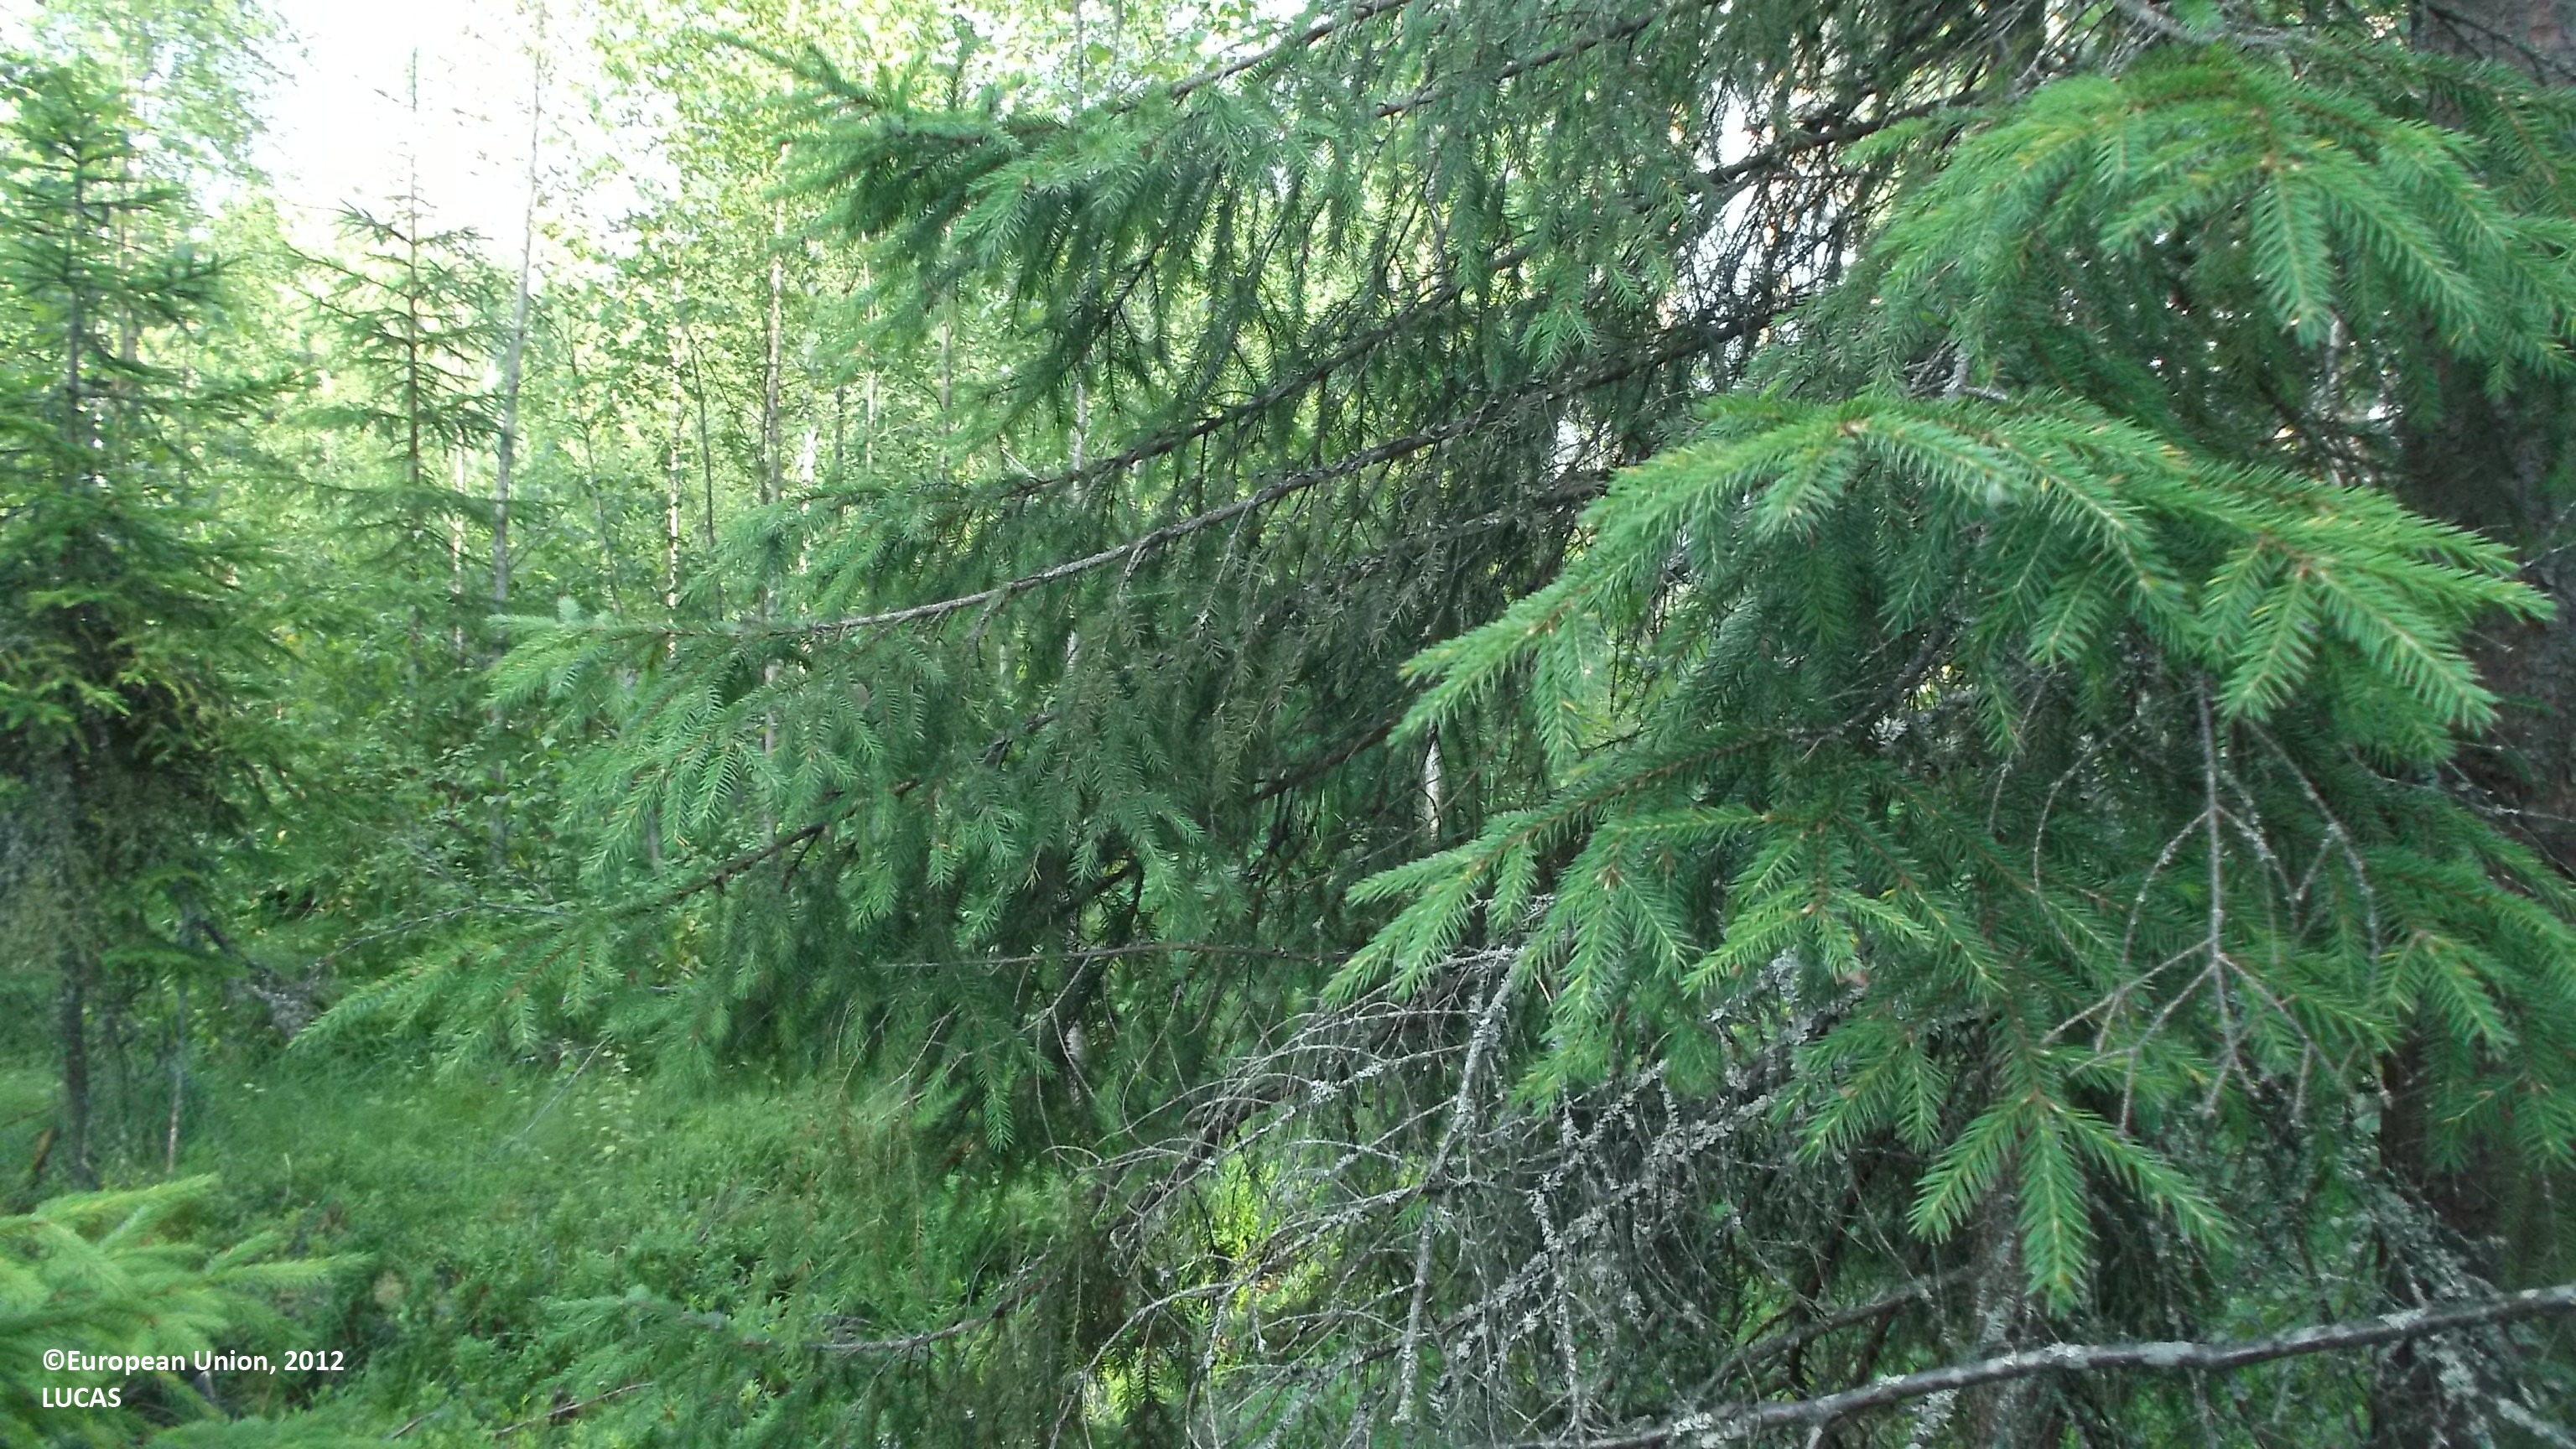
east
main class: Woodland
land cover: Other coniferous woodland
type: boreal forest
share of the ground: 25 - 50 %
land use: Forestry
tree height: > 5 m
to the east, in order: Other coniferous woodland; Other mixed woodland; Pine dominated mixed woodland; Broadleaved woodland; Pine dominated mixed woodland; Ditches and canals; Tracks; Grass margins; Ditches and canals; Grass margins; Oats; Grass margins; Ditches and canals; Spontaneously vegetated surfaces; Oats
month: July
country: FI
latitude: 63.2026
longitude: 23.8081
